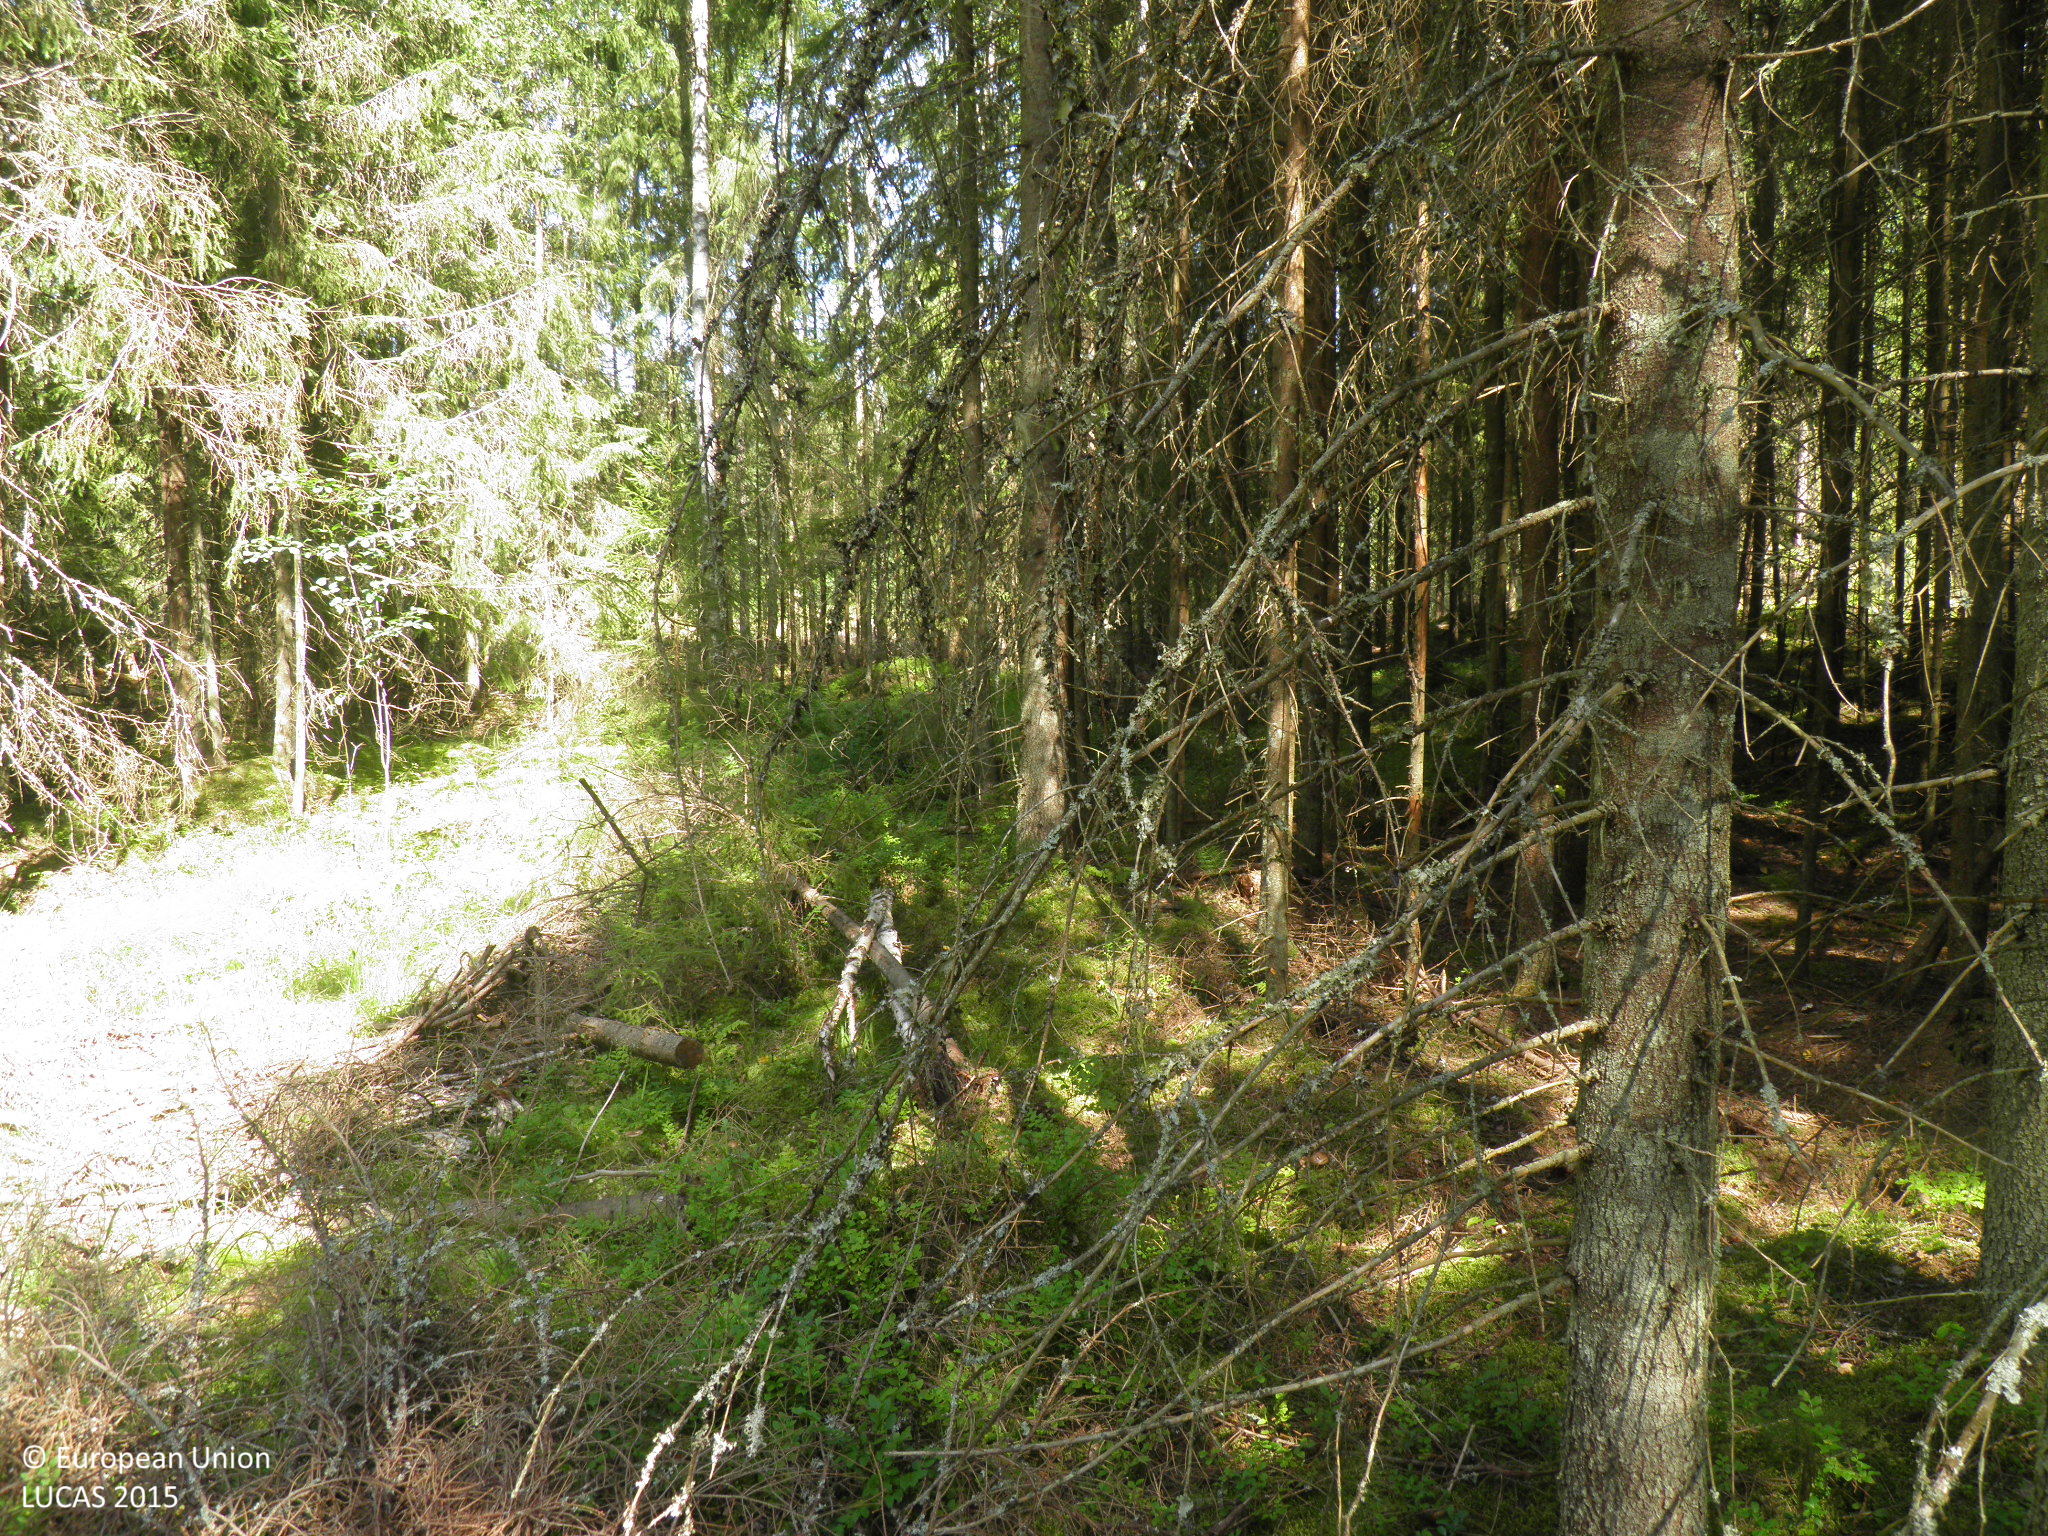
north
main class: Woodland
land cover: Spruce dominated coniferous woodland
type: hemiboreal forest and nemoral coniferous forest and mixed broadleaved-coniferous forest
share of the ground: > 75 %
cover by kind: coniferous forest trees 90 %, shrubs 5 %, lichens and mosses 5 %
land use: Forestry
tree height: > 5 m
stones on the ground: < 10 %
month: August
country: FI
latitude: 61.0394
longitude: 22.7900
